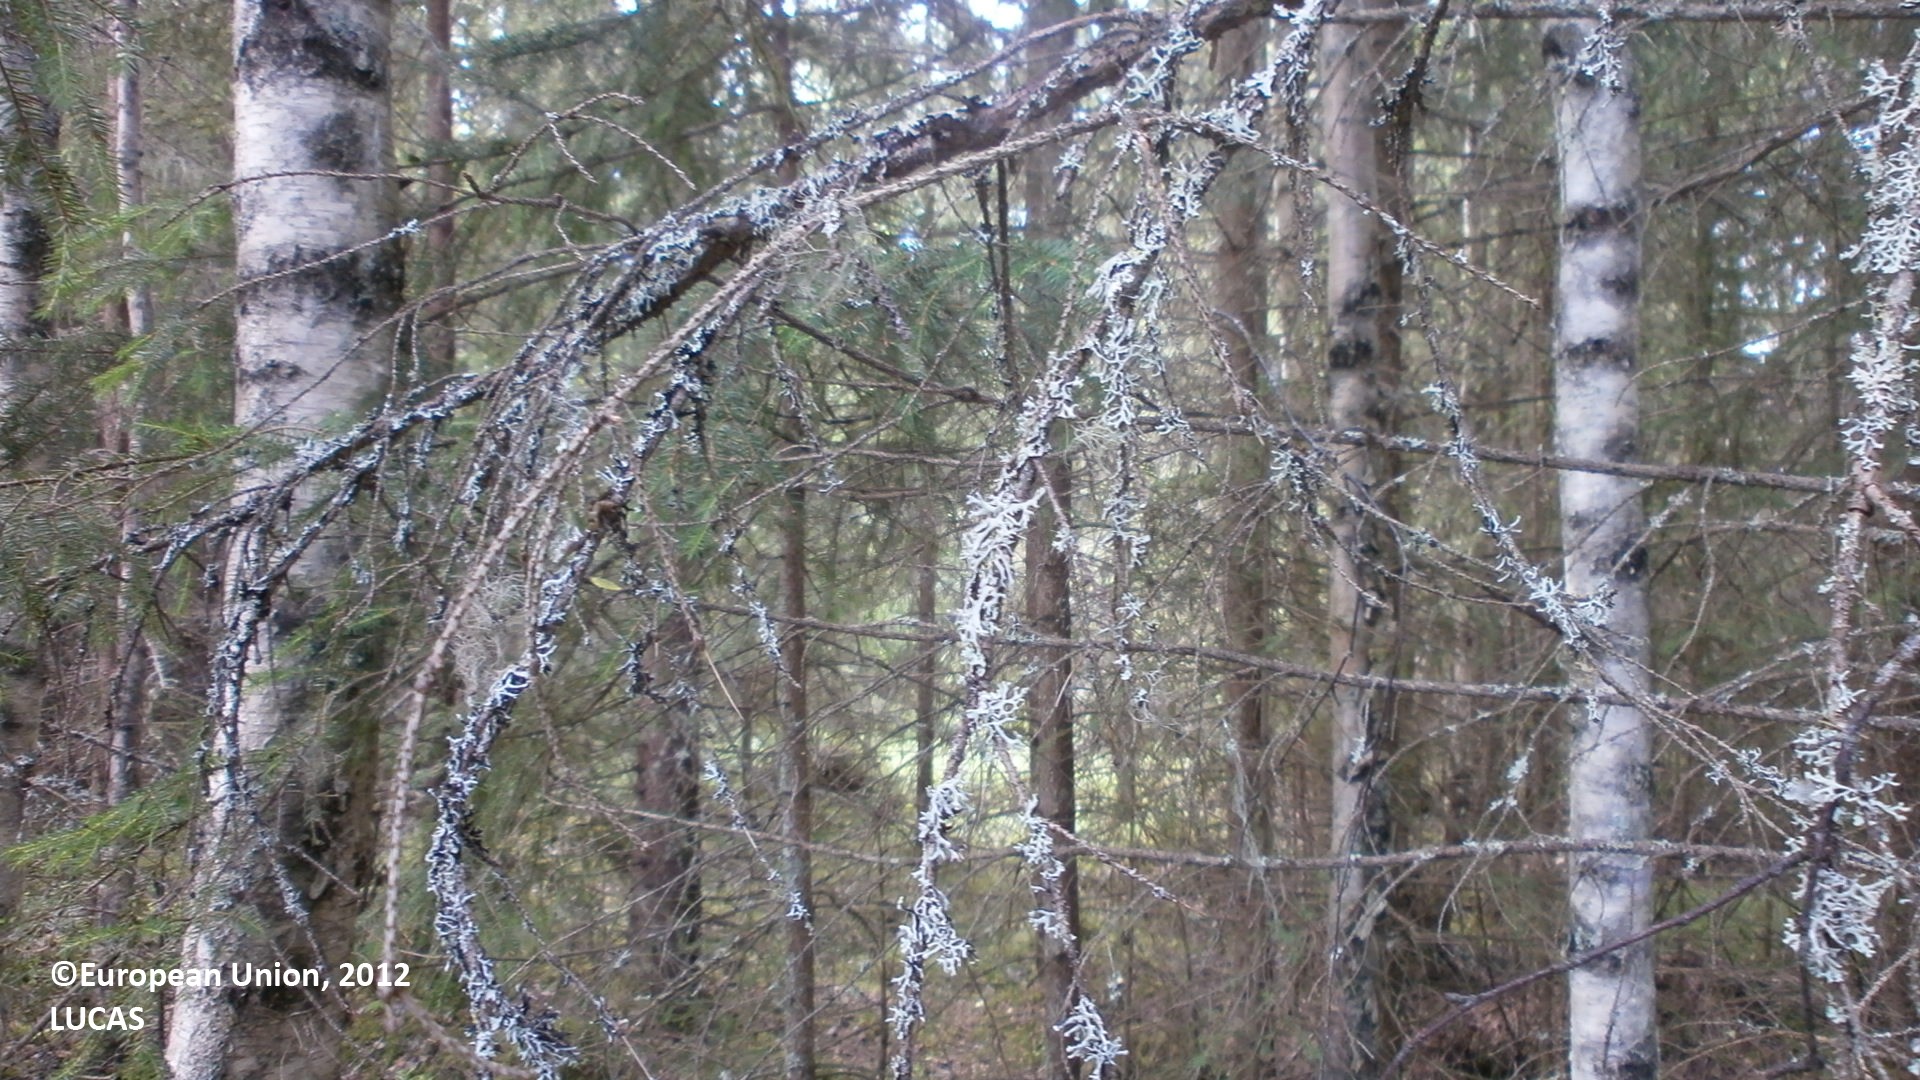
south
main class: Woodland
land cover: Spruce dominated mixed woodland
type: boreal forest
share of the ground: > 75 %
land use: Forestry
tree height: > 5 m
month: July
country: FI
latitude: 64.0230
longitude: 24.2920
